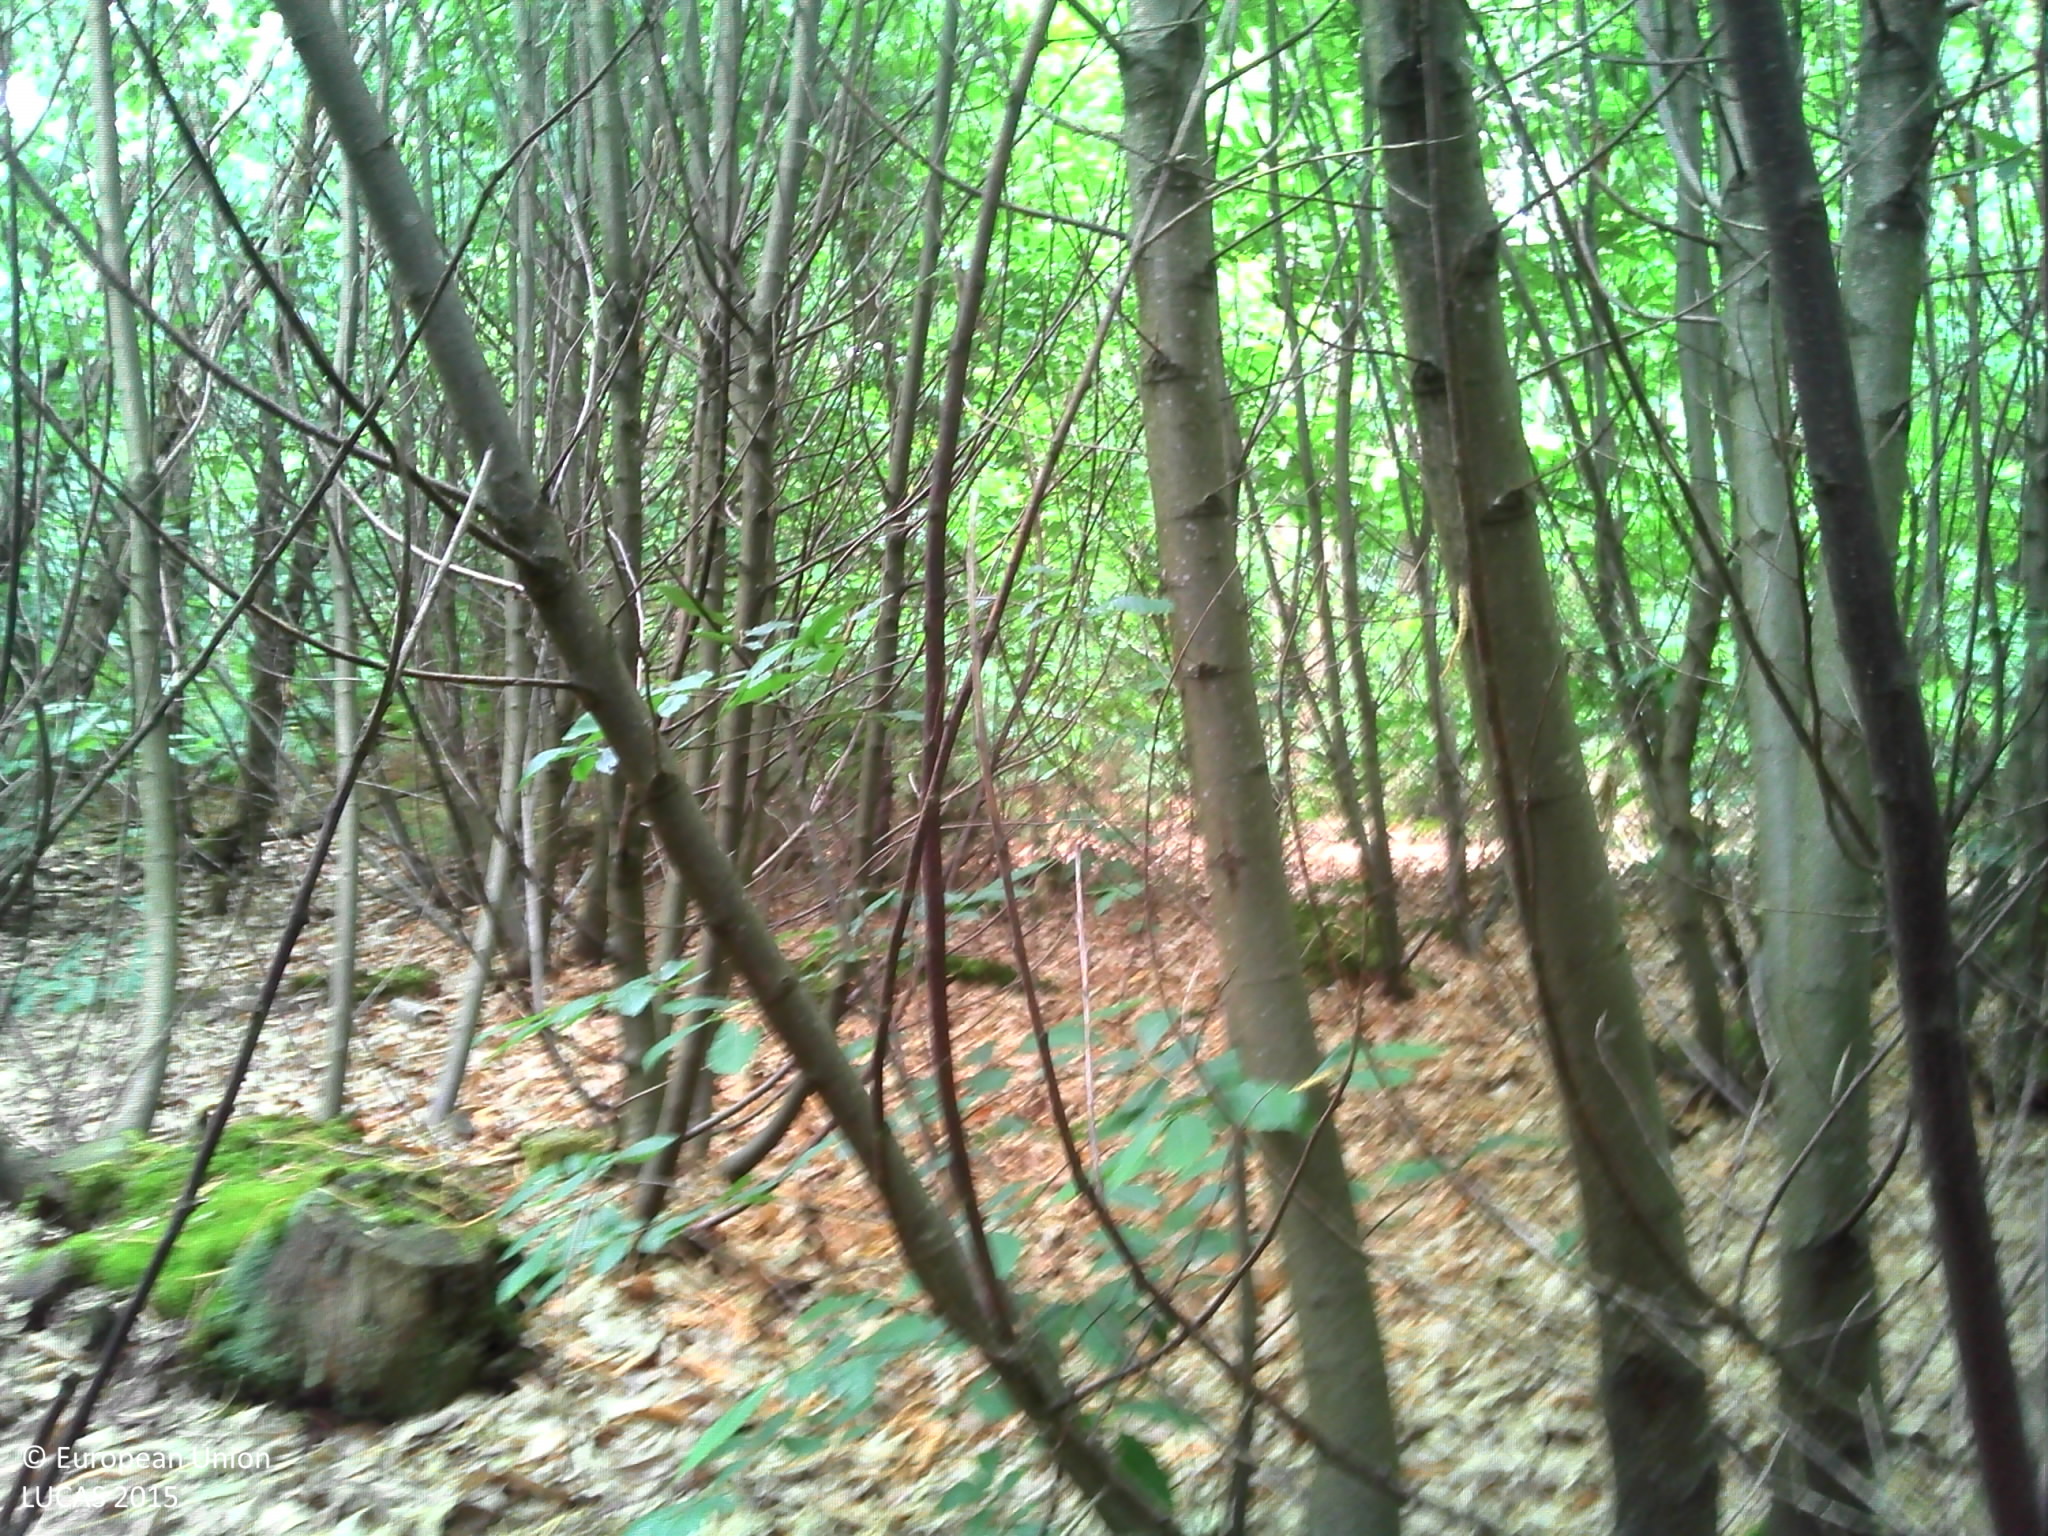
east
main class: Woodland
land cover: Broadleaved woodland
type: thermophilous deciduous forest
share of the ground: > 75 %
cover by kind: broadleaved forest trees 90 %, herbaceous plants 5 %, lichens and mosses 5 %
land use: Forestry
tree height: > 5 m
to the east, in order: Broadleaved woodland; Ditches and canals; Grass margins; Paved roads, cycling and walking lanes; Ditches and canals; Grass margins; Broadleaved woodland
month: July
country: FR
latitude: 47.8017
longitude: -2.0008
